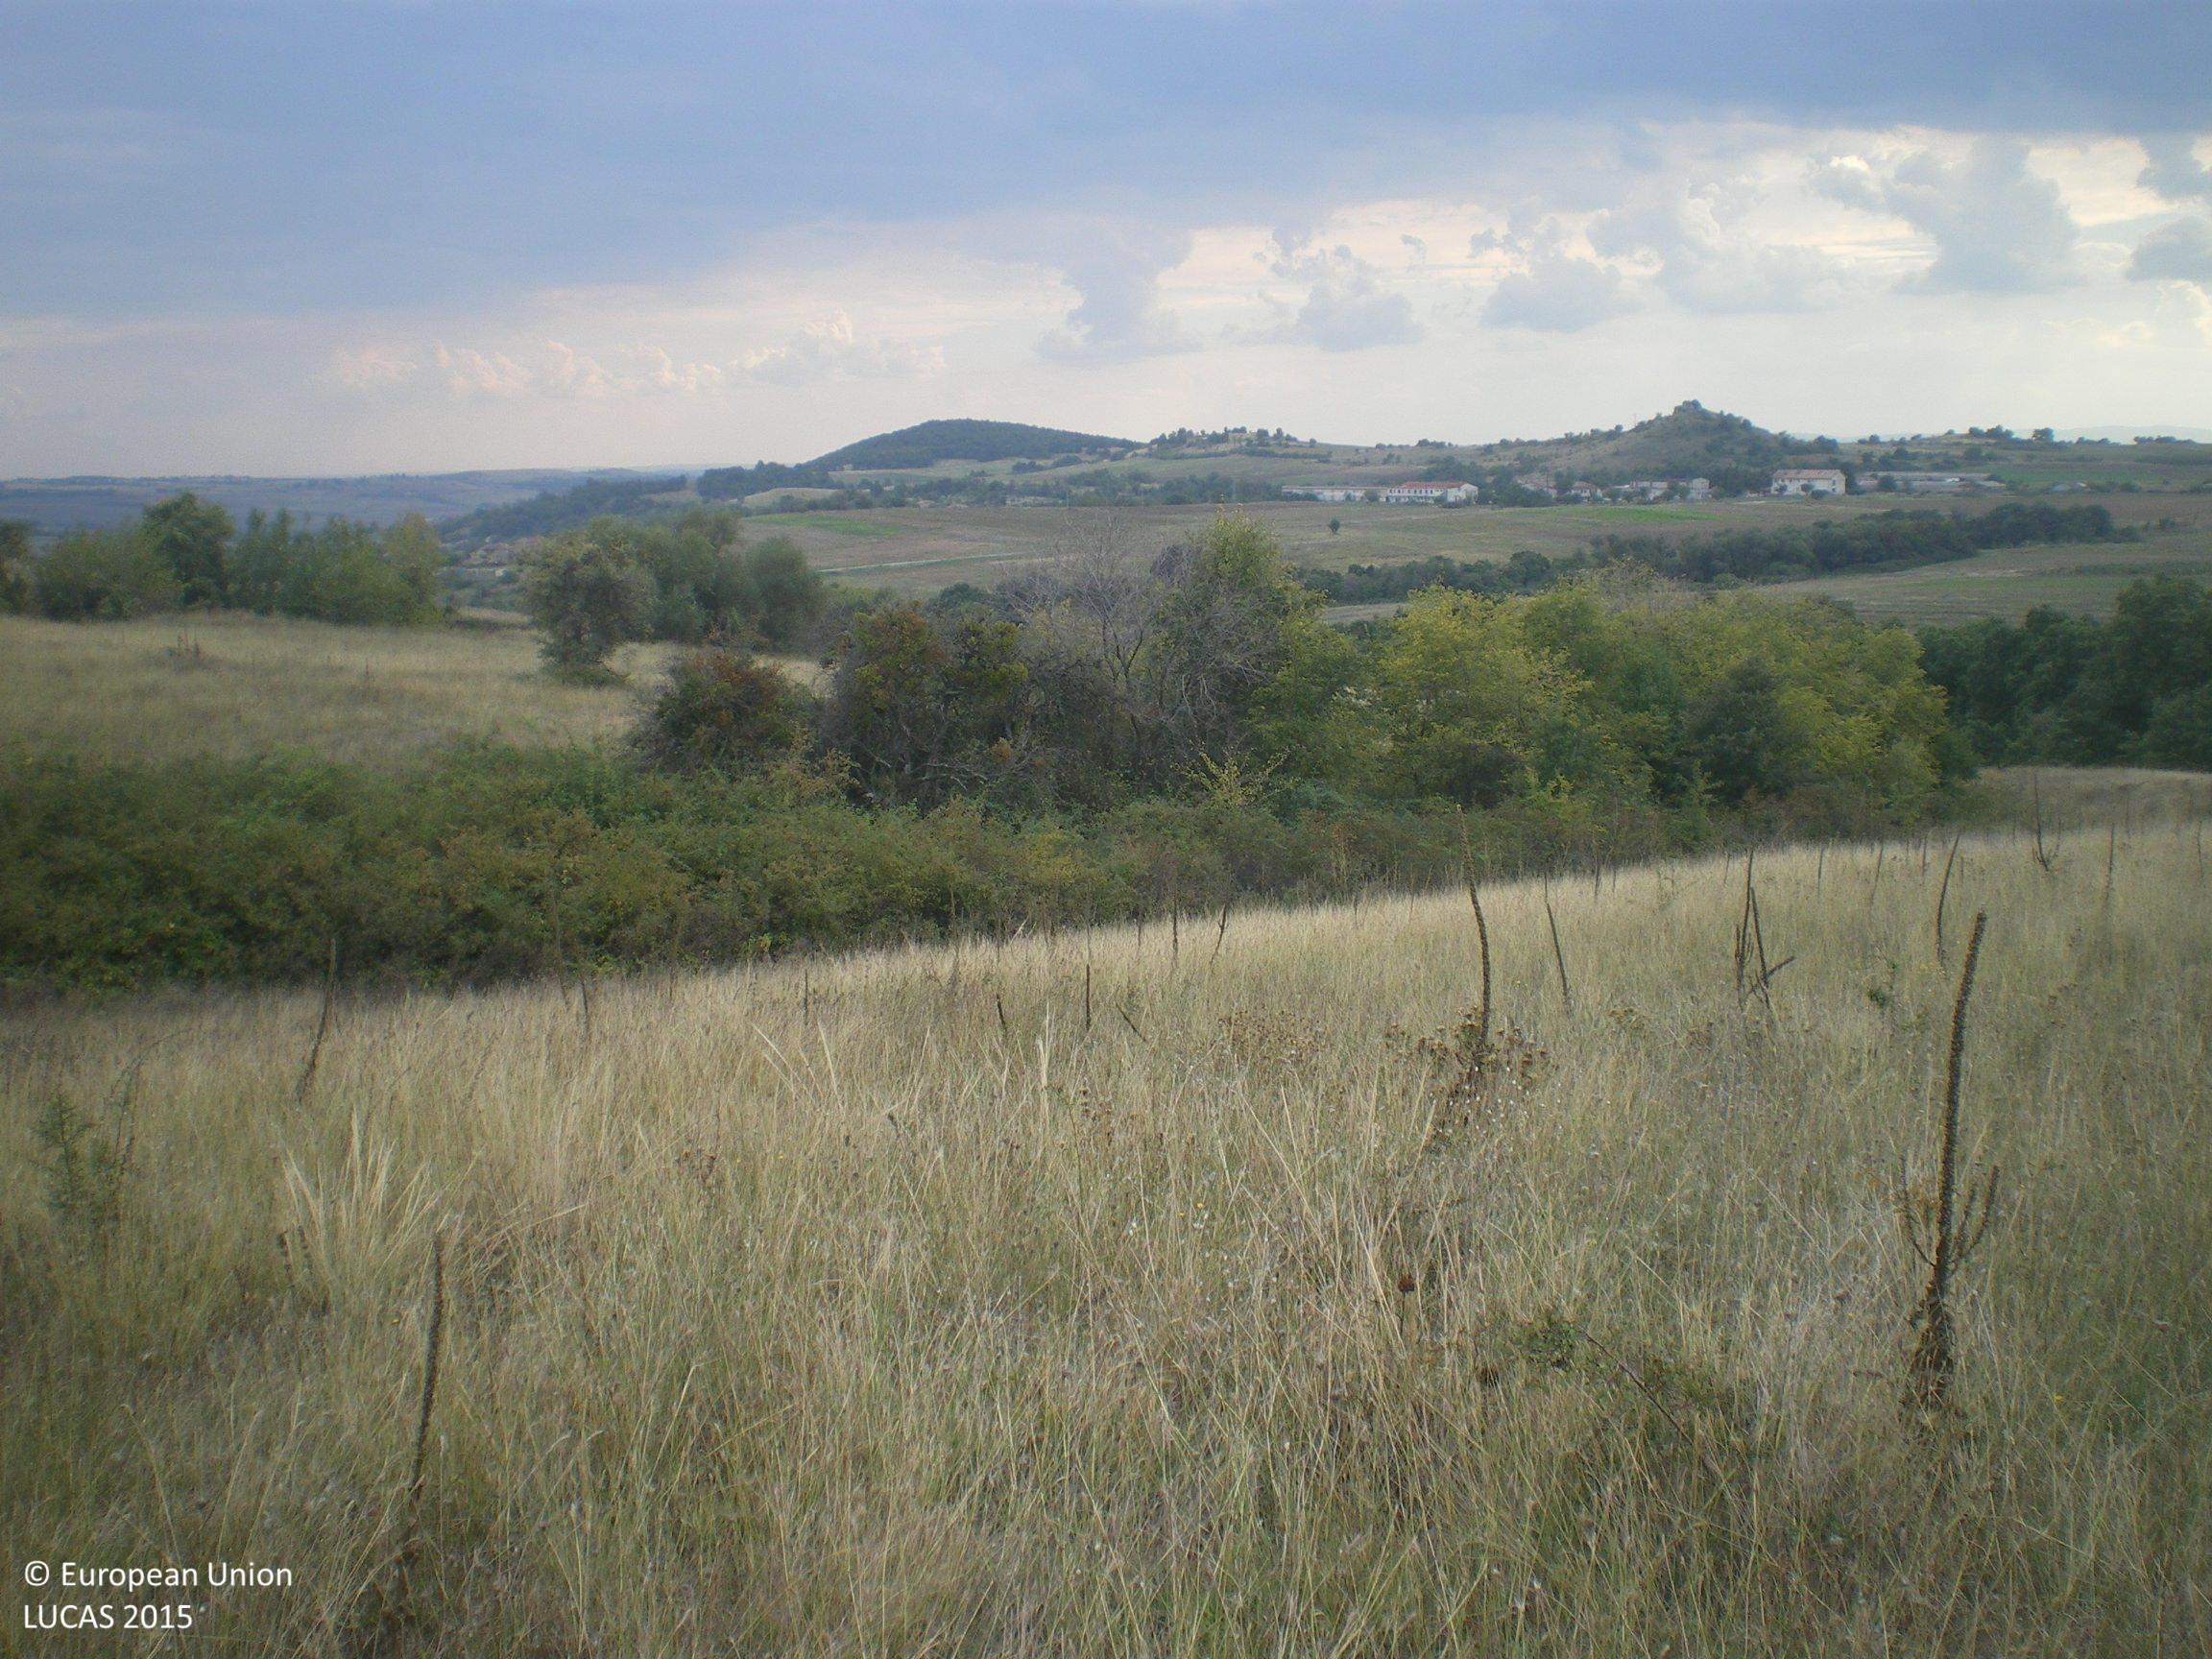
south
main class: Grassland
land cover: Grassland without tree/shrub cover
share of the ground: > 75 %
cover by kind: herbaceous plants 100 %
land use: Agriculture (excluding fallow land and kitchen gardens)
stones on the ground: 10 - 25 %
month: October
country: BG
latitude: 41.8811
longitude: 26.2623
